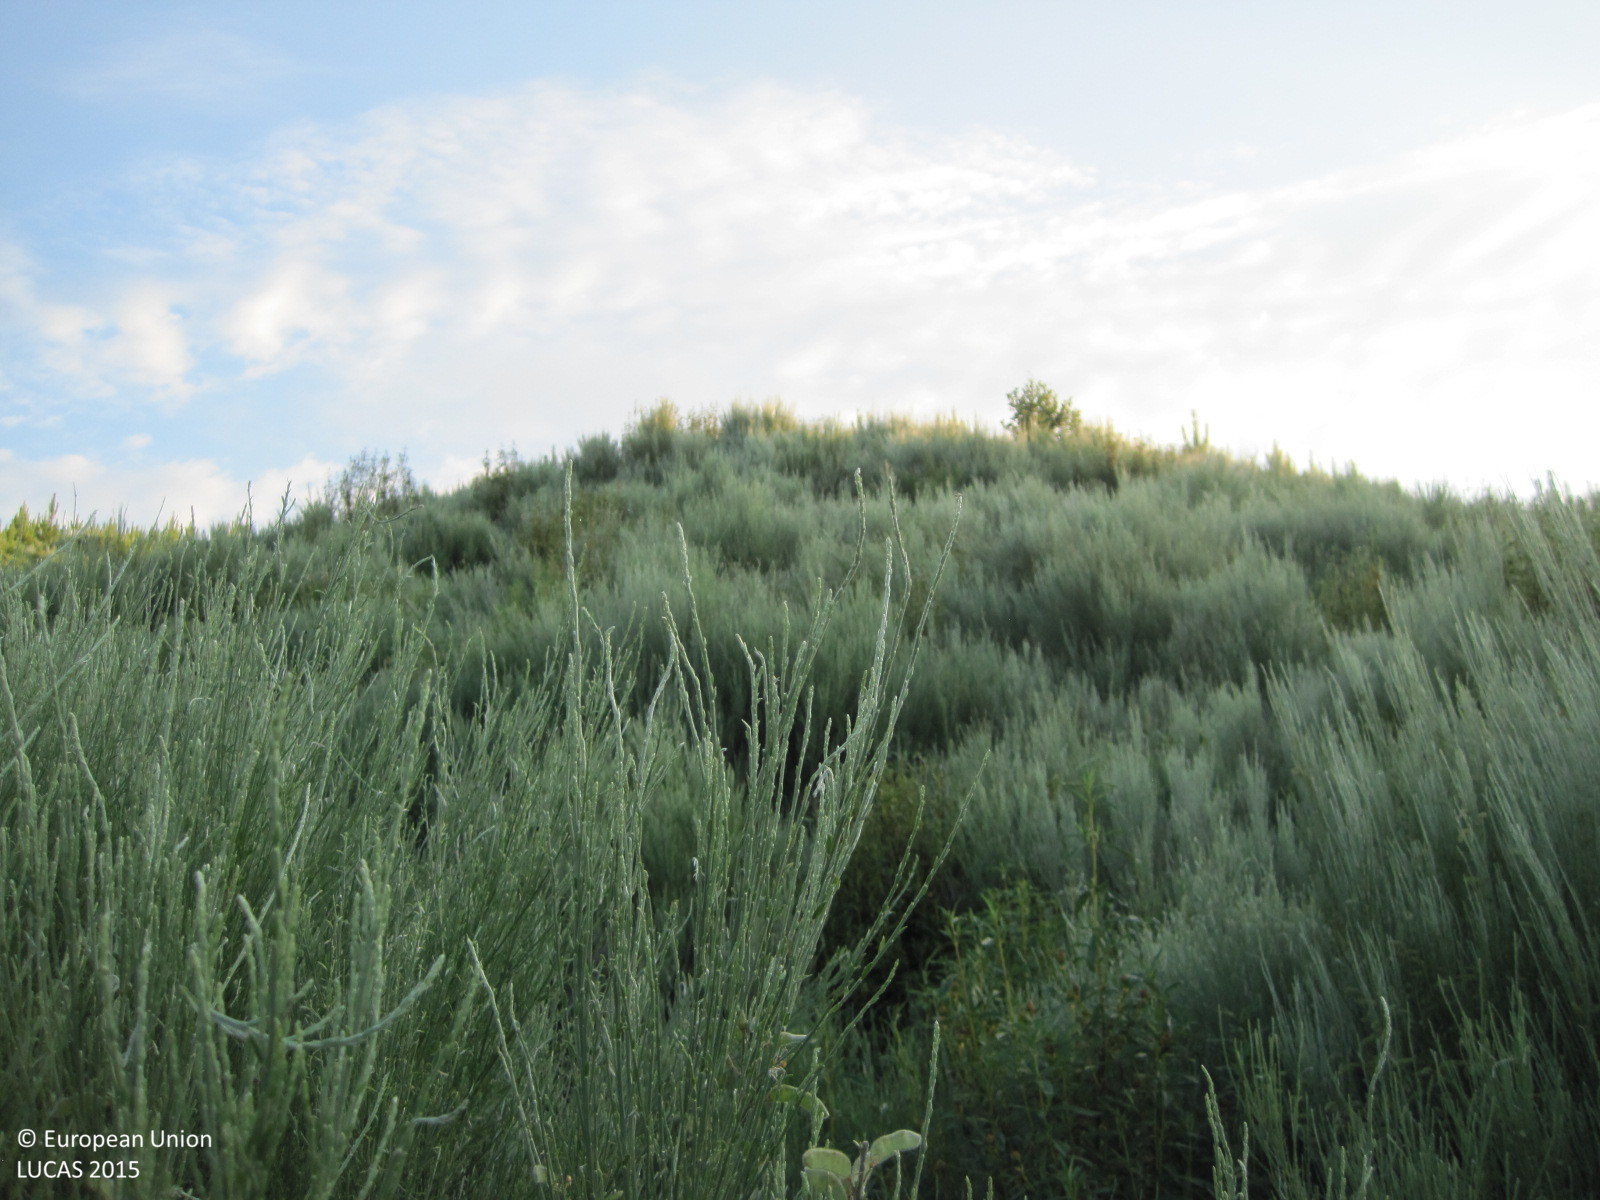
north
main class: Woodland
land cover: Pine dominated coniferous woodland
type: coniferous forest of the mediterranean region
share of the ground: > 75 %
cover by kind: coniferous forest trees 90 %, shrubs 10 %
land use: Forestry
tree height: < 5 m
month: June
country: ES
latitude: 40.2565
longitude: -5.0463
